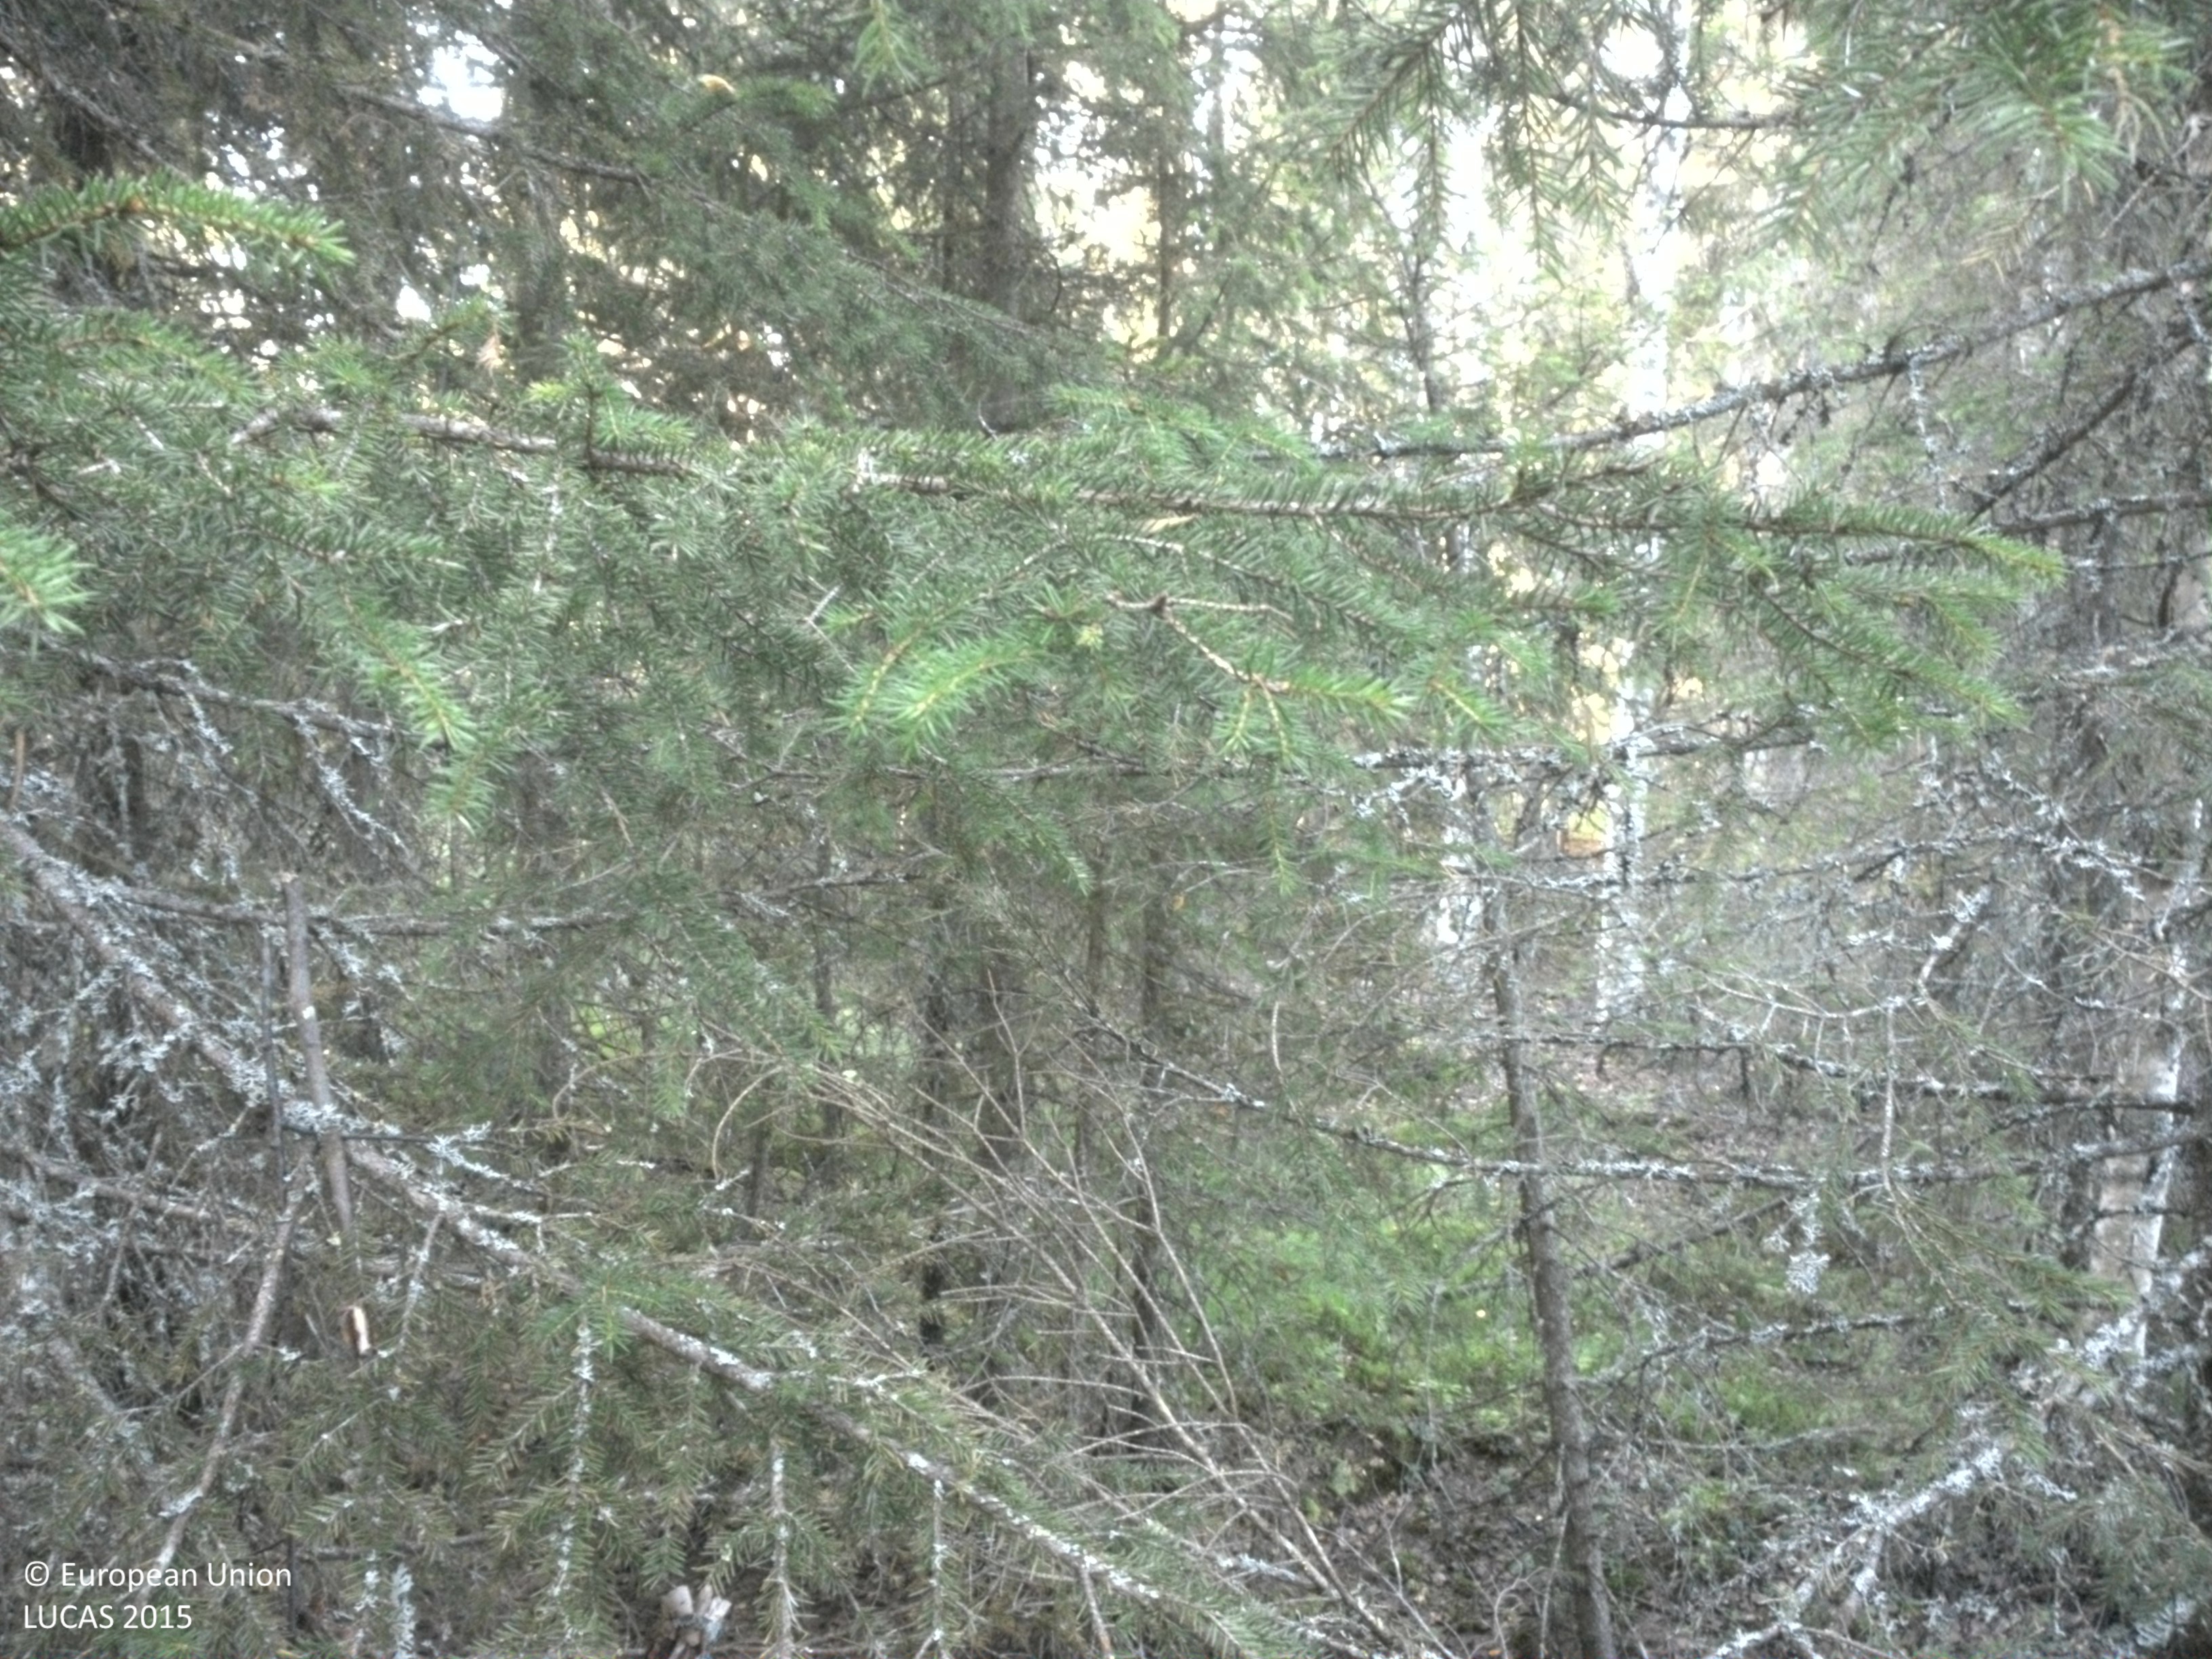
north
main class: Woodland
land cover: Spruce dominated mixed woodland
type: boreal forest
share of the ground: > 75 %
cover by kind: coniferous forest trees 60 %, broadleaved forest trees 20 %, herbaceous plants 20 %
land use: Forestry
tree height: > 5 m
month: August
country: SE
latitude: 64.3931
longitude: 18.4092
